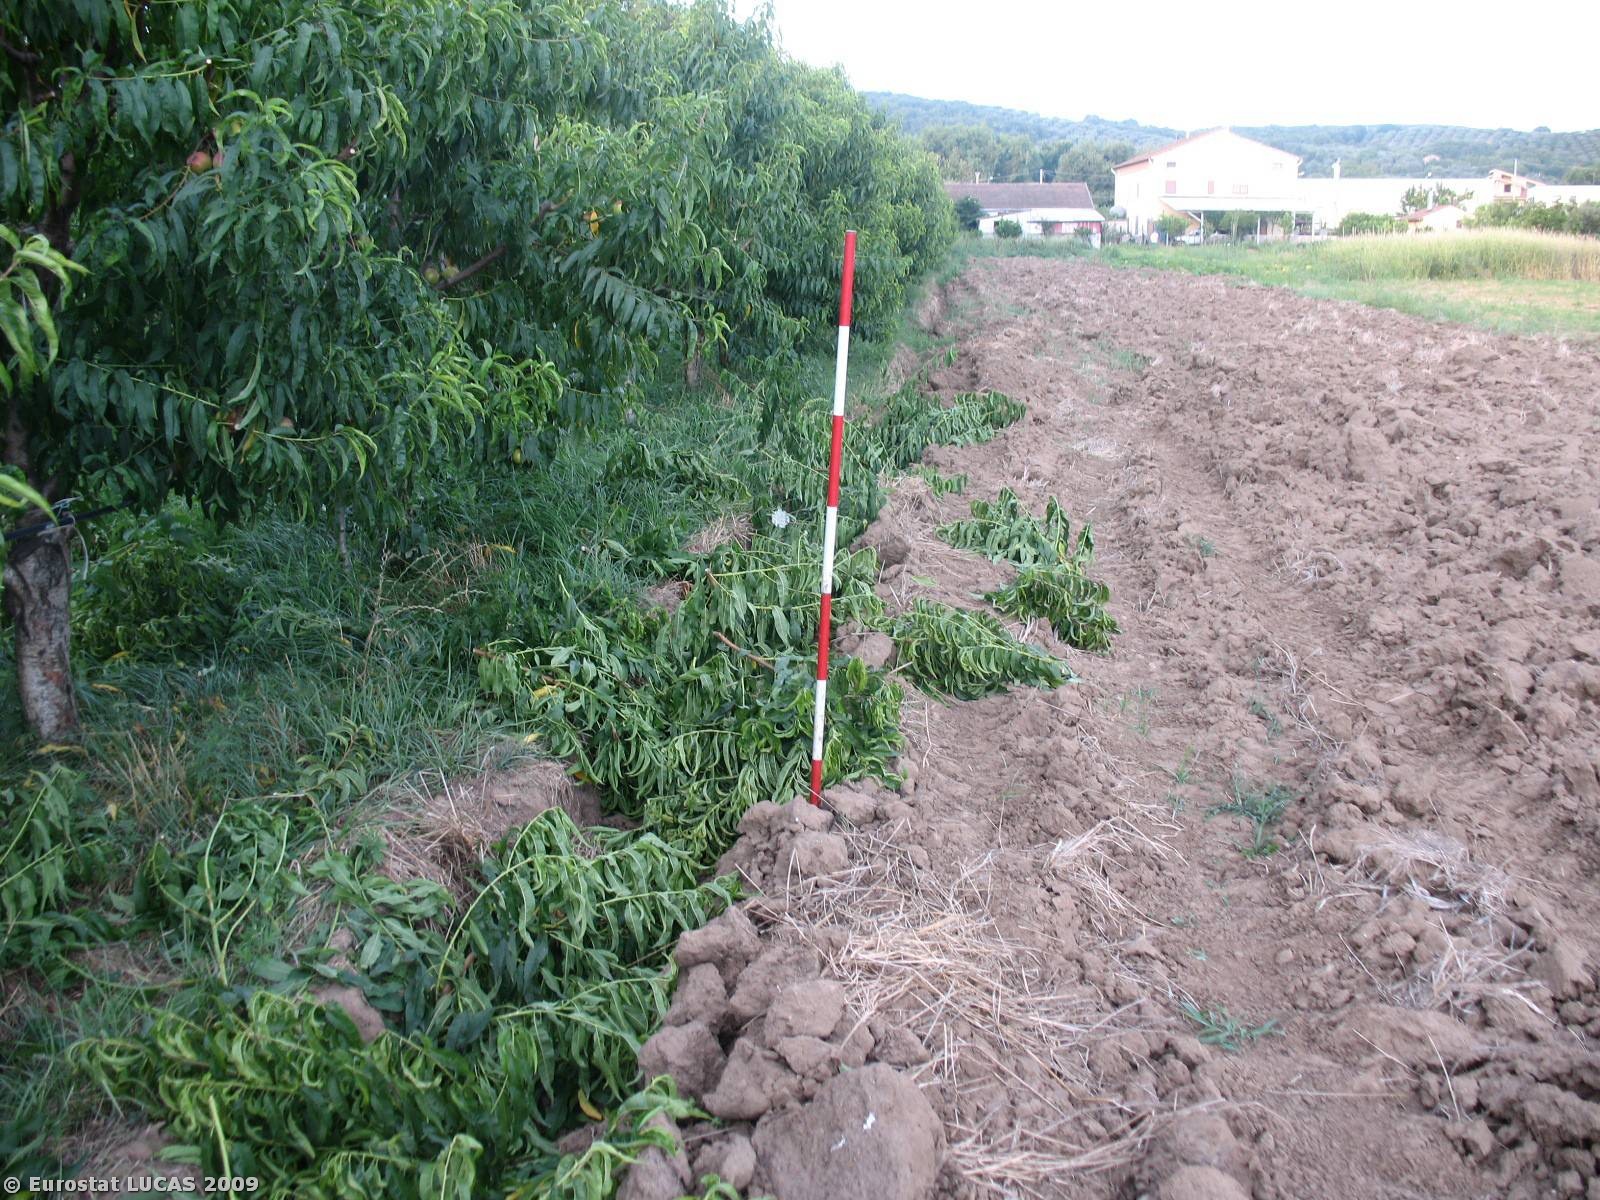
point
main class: Cropland
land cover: Temporary grasslands
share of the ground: < 10 %
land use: Agriculture (excluding fallow land and kitchen gardens)
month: July
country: IT
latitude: 40.4991
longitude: 15.0642
